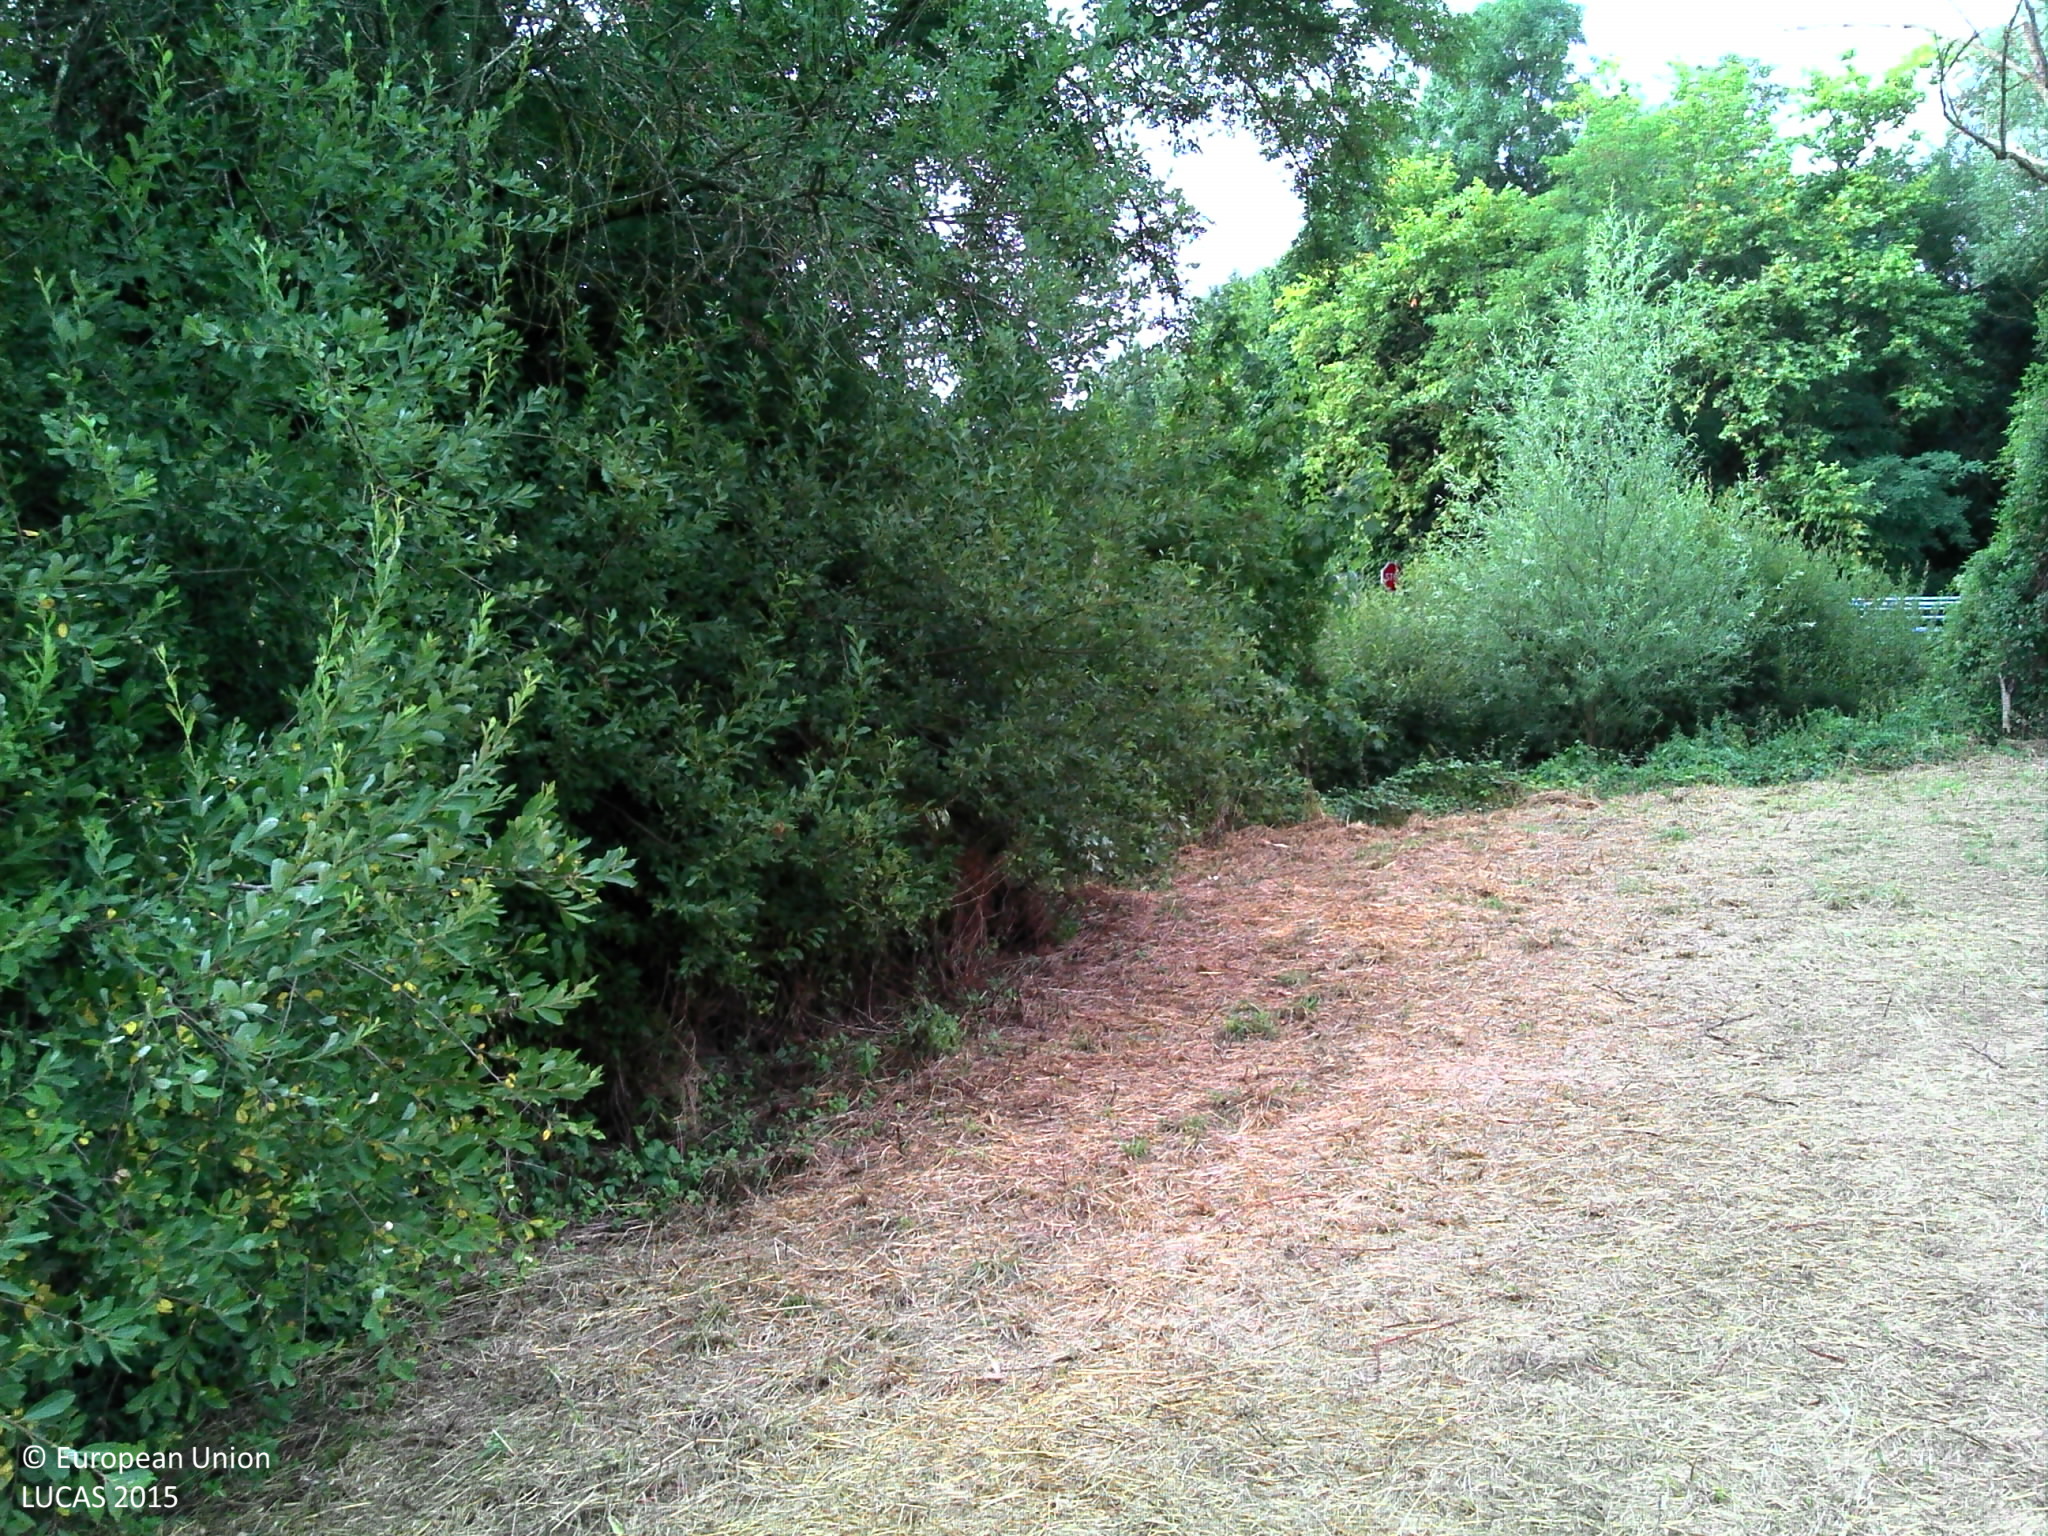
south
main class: Grassland
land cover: Grassland without tree/shrub cover
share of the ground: > 75 %
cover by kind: herbaceous plants 100 %
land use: Agriculture (excluding fallow land and kitchen gardens)
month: August
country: FR
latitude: 46.4720
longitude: 0.3046
